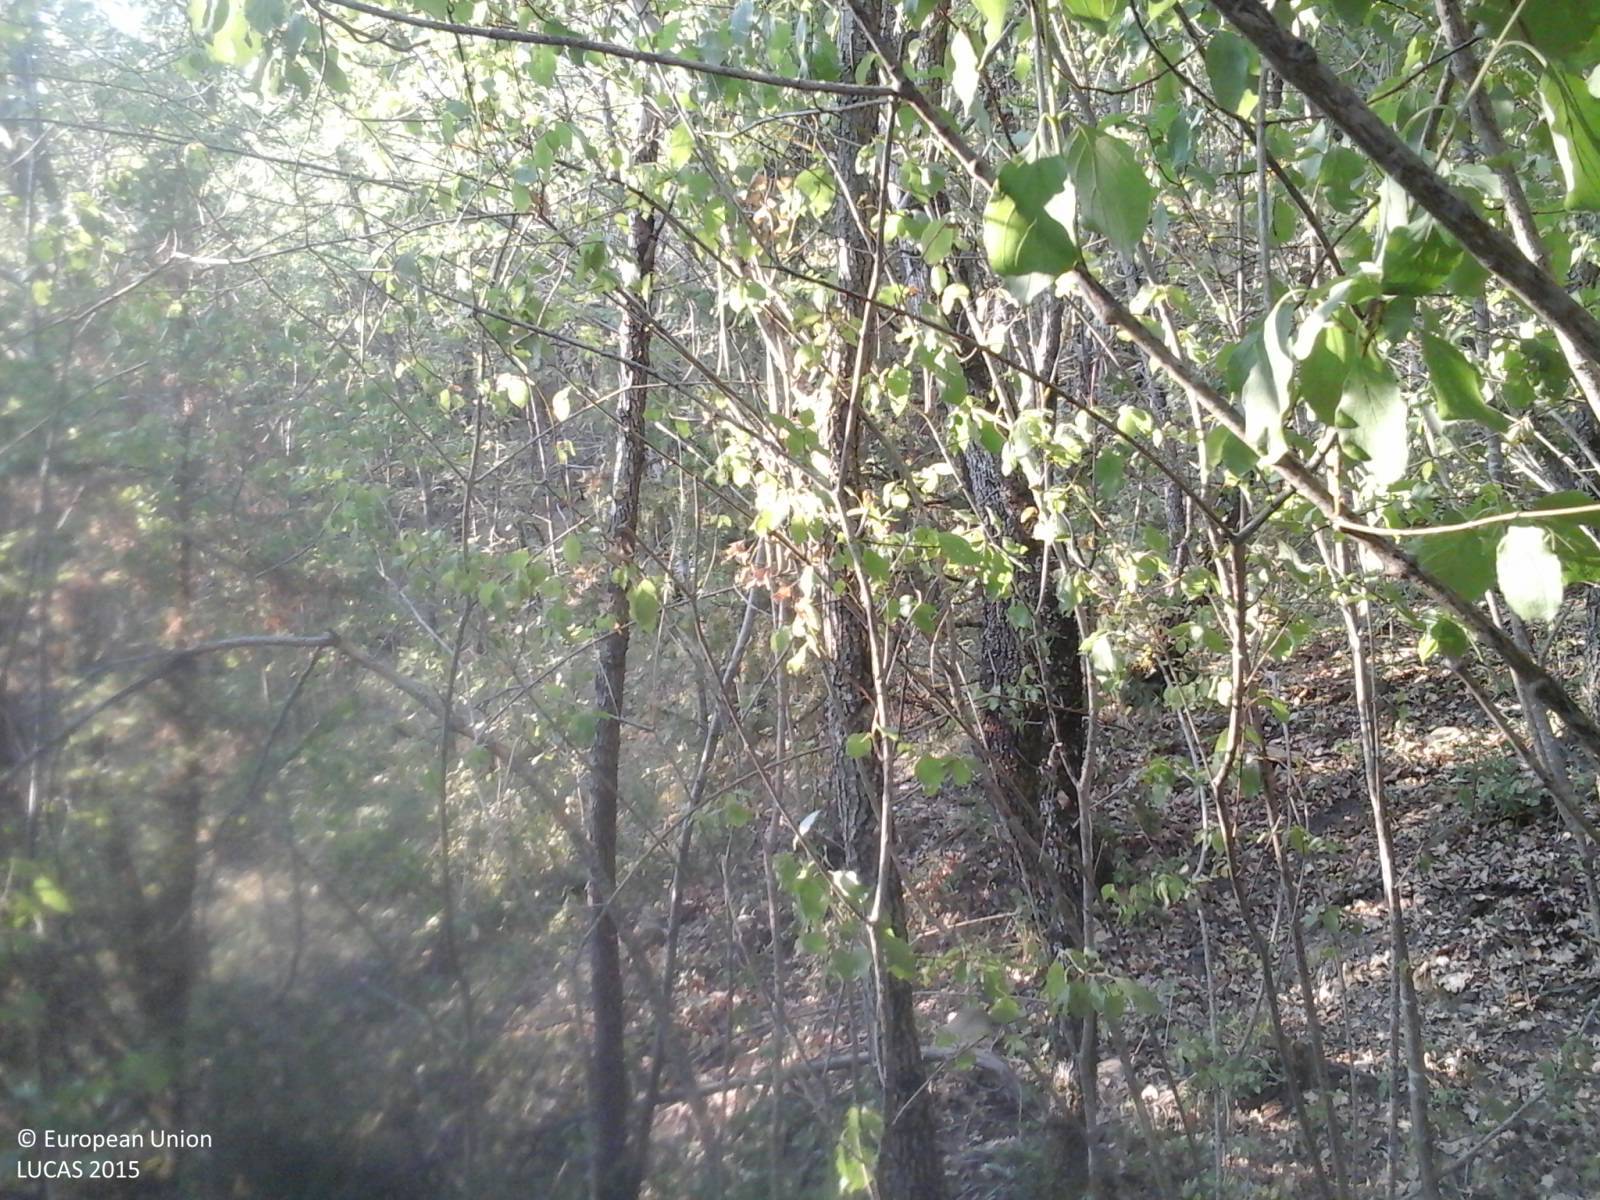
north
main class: Woodland
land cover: Broadleaved woodland
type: thermophilous deciduous forest
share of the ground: > 75 %
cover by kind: broadleaved forest trees 90 %, shrubs 10 %
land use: Forestry
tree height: > 5 m
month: August
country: IT
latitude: 43.5574
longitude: 11.8890
